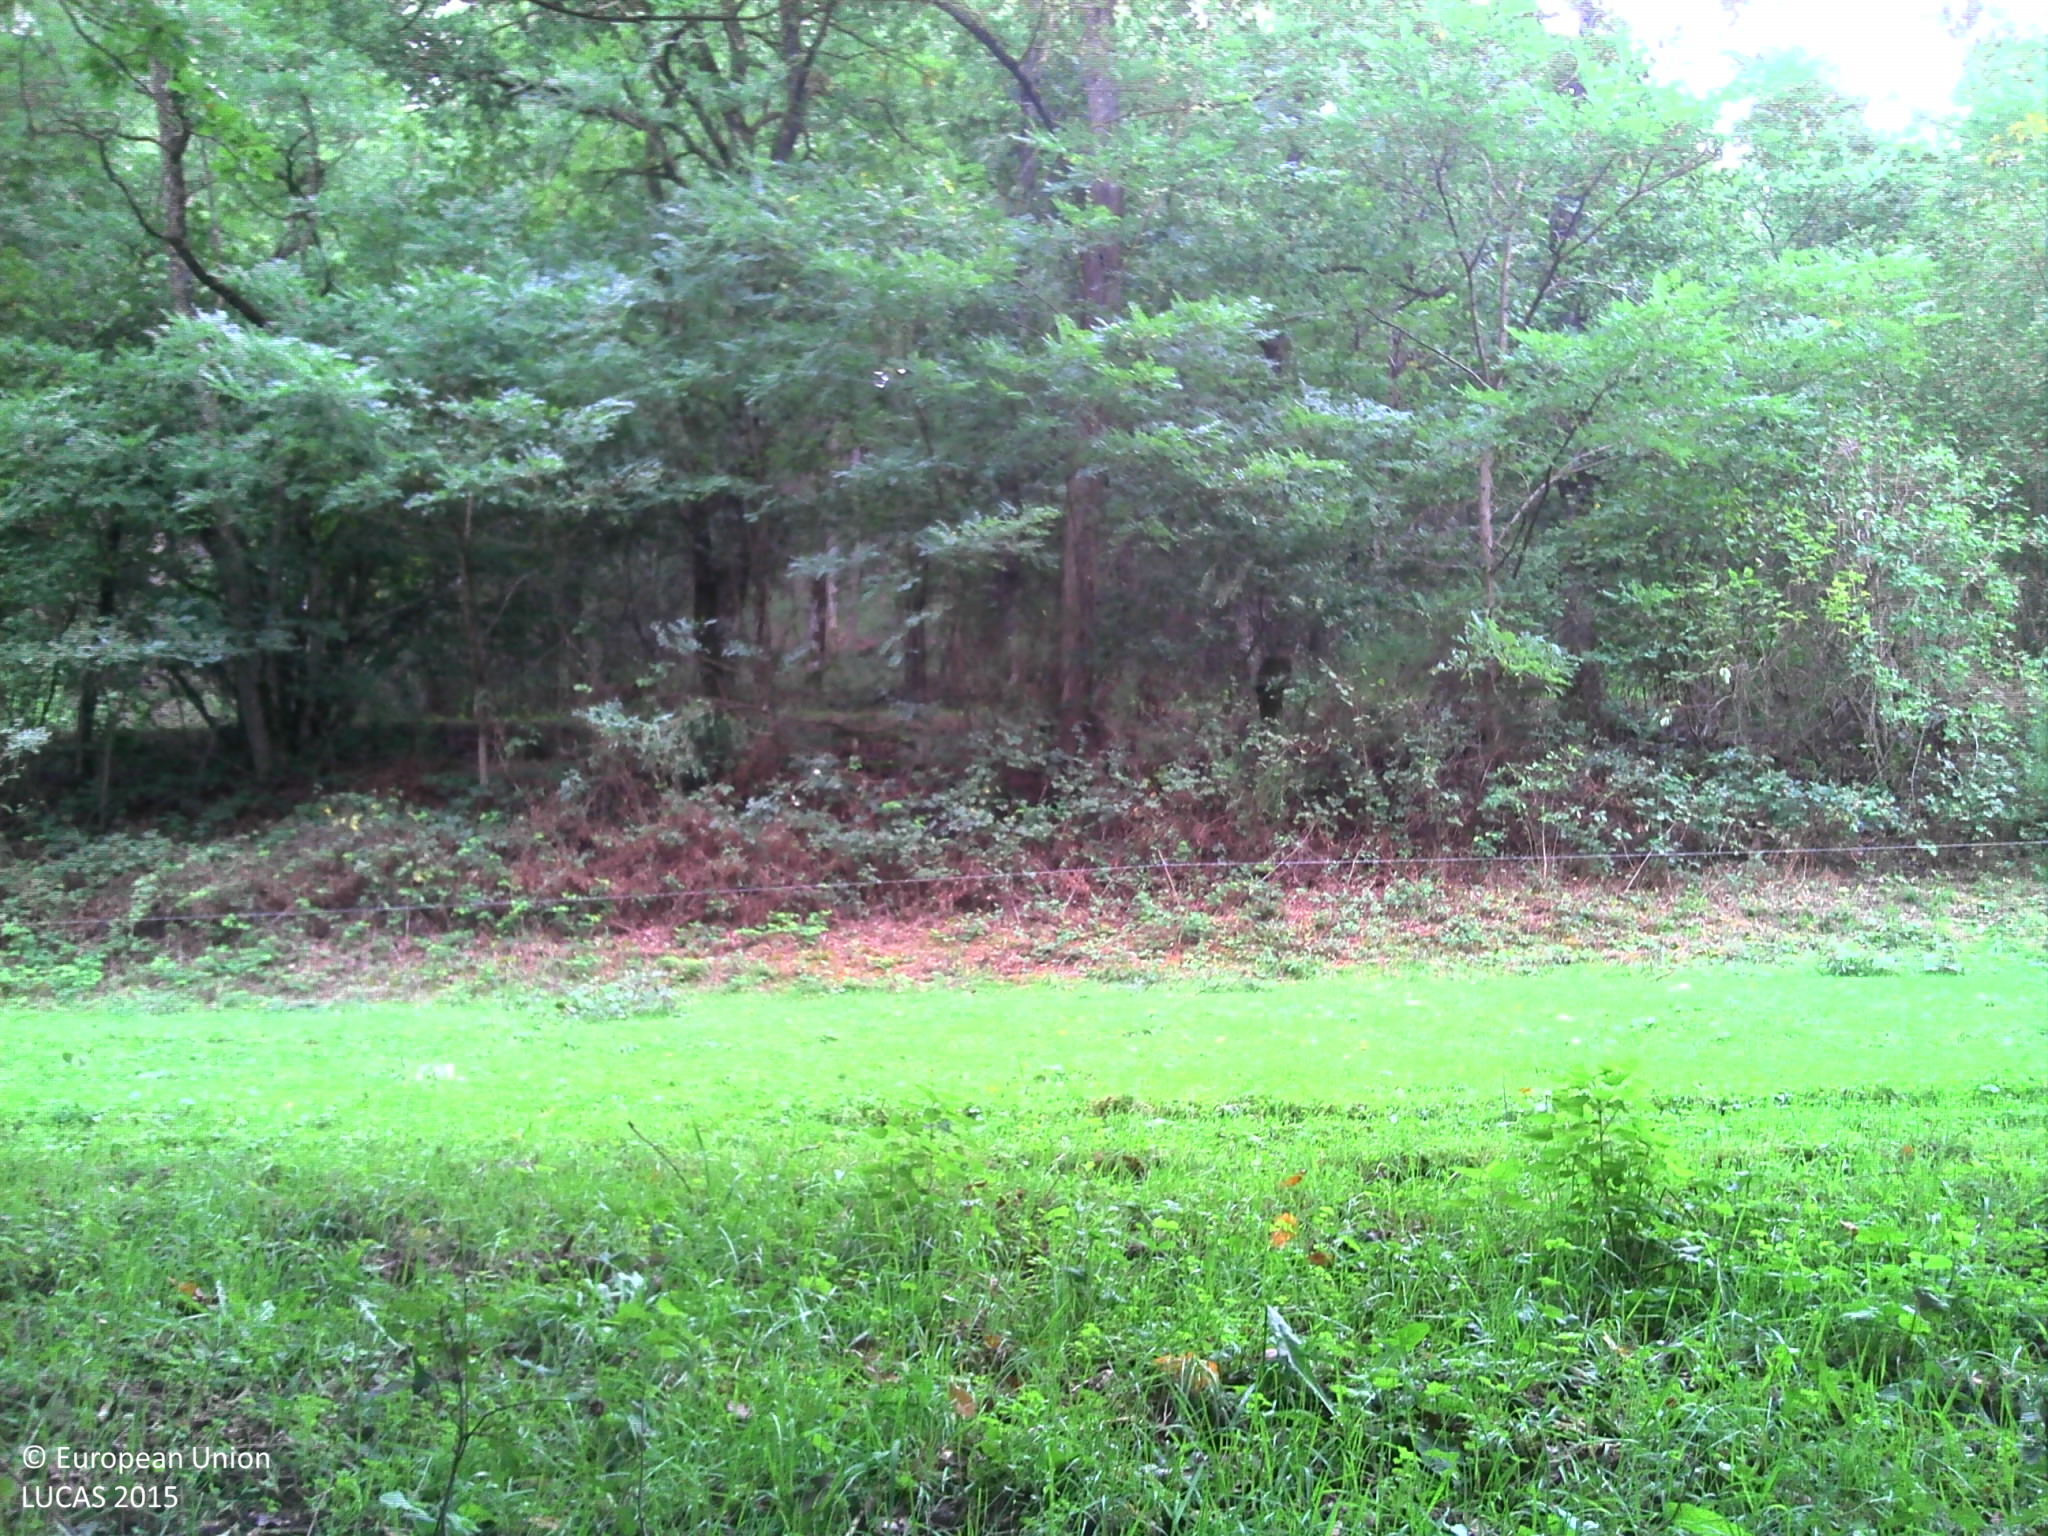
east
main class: Woodland
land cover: Broadleaved woodland
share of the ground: > 75 %
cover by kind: broadleaved forest trees 100 %
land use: Semi-natural and natural areas not in use
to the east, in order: Broadleaved woodland; Fences; Grassland without tree/shrub cover; Fences; Broadleaved woodland; Grass margins; Paved roads, cycling and walking lanes; Grass margins; Broadleaved woodland; Tracks; Broadleaved woodland; Other mixed woodland; Broadleaved woodland
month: September
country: FR
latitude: 47.0876
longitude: 4.3750
